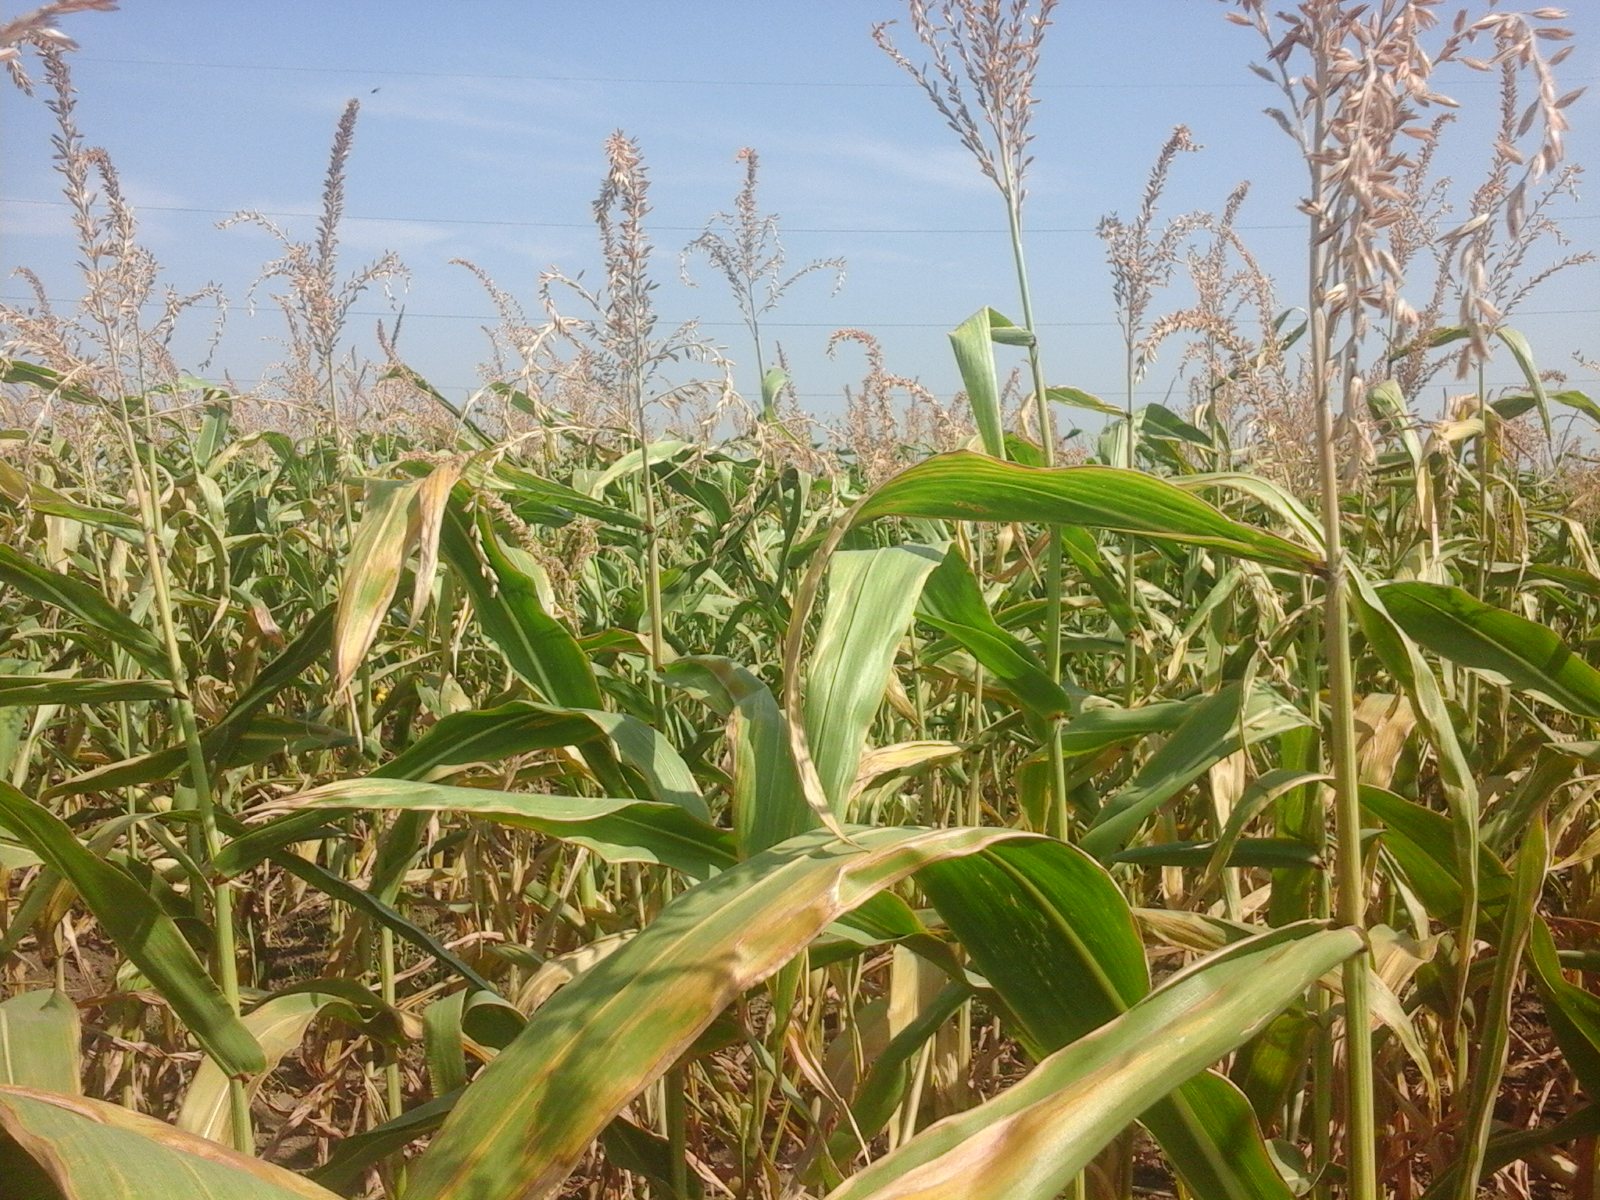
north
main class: Cropland
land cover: Maize
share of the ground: > 75 %
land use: Agriculture (excluding fallow land and kitchen gardens)
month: August
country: RO
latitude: 45.8081
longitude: 27.6486
